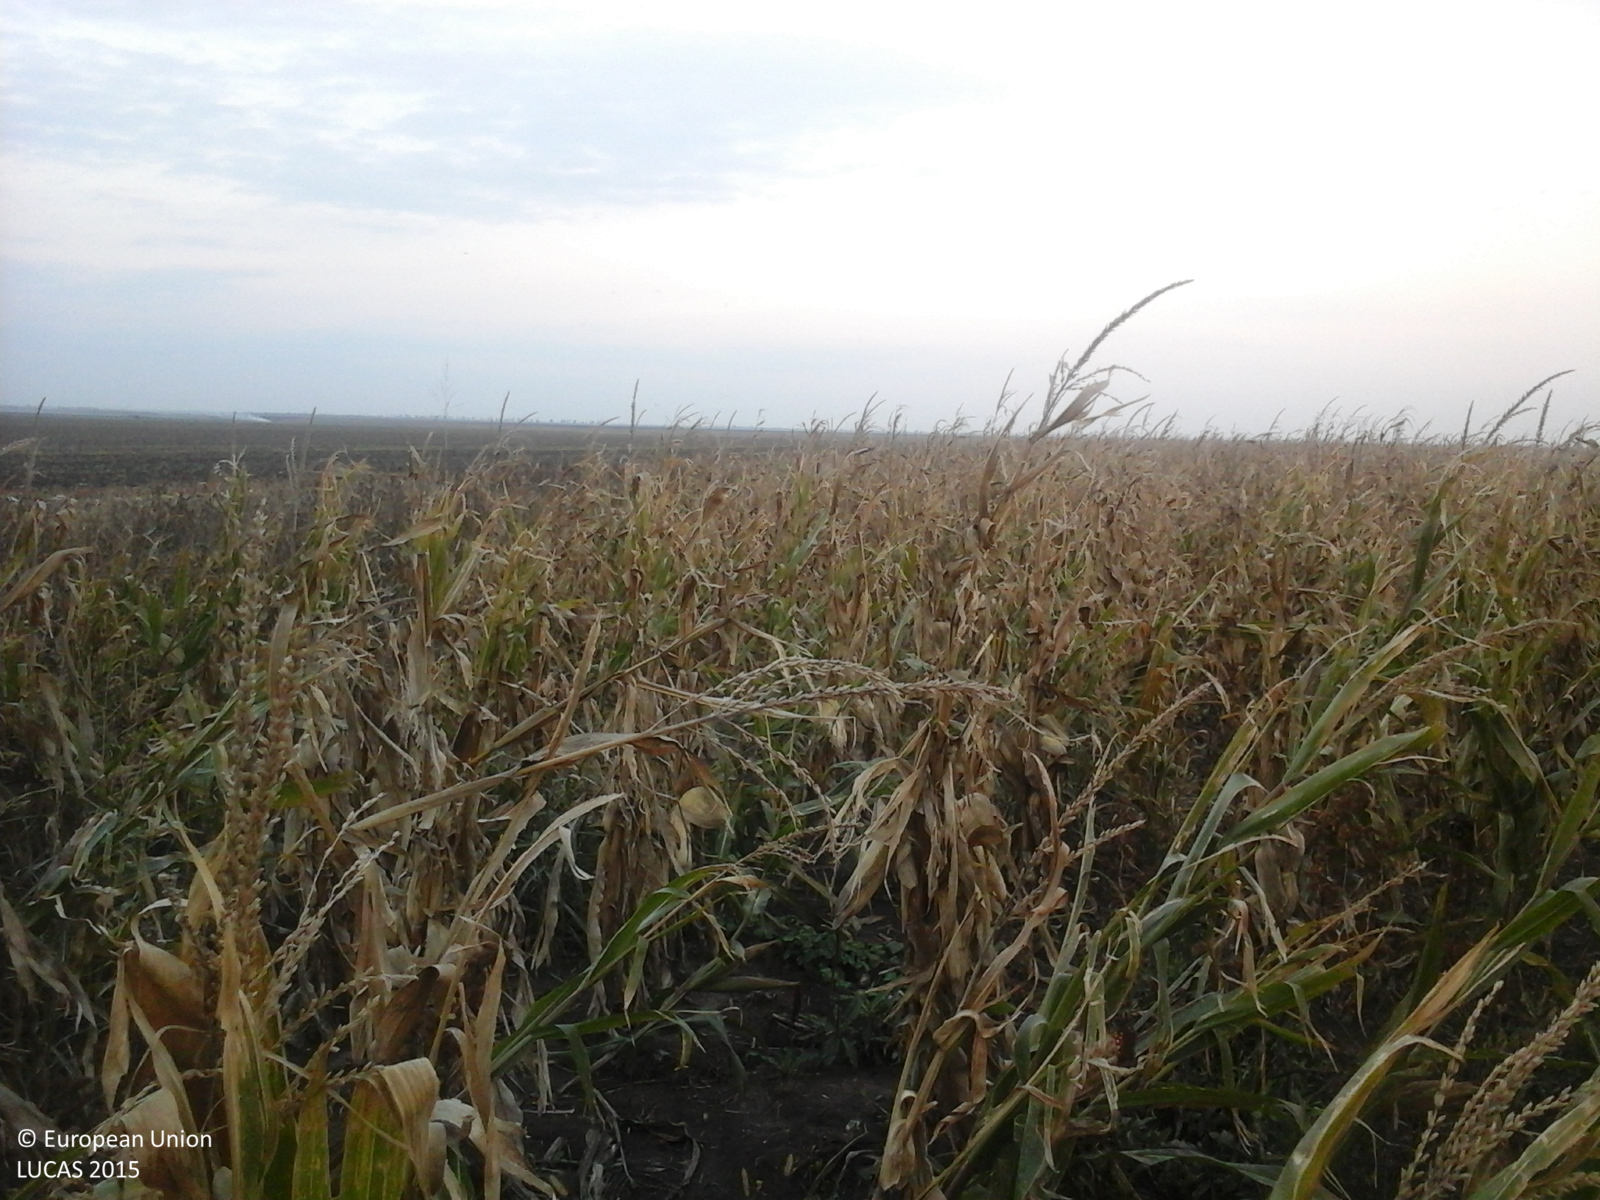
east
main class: Cropland
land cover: Maize
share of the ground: > 75 %
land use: Agriculture (excluding fallow land and kitchen gardens)
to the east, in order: Maize
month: October
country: RO
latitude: 45.2542
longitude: 26.9947
